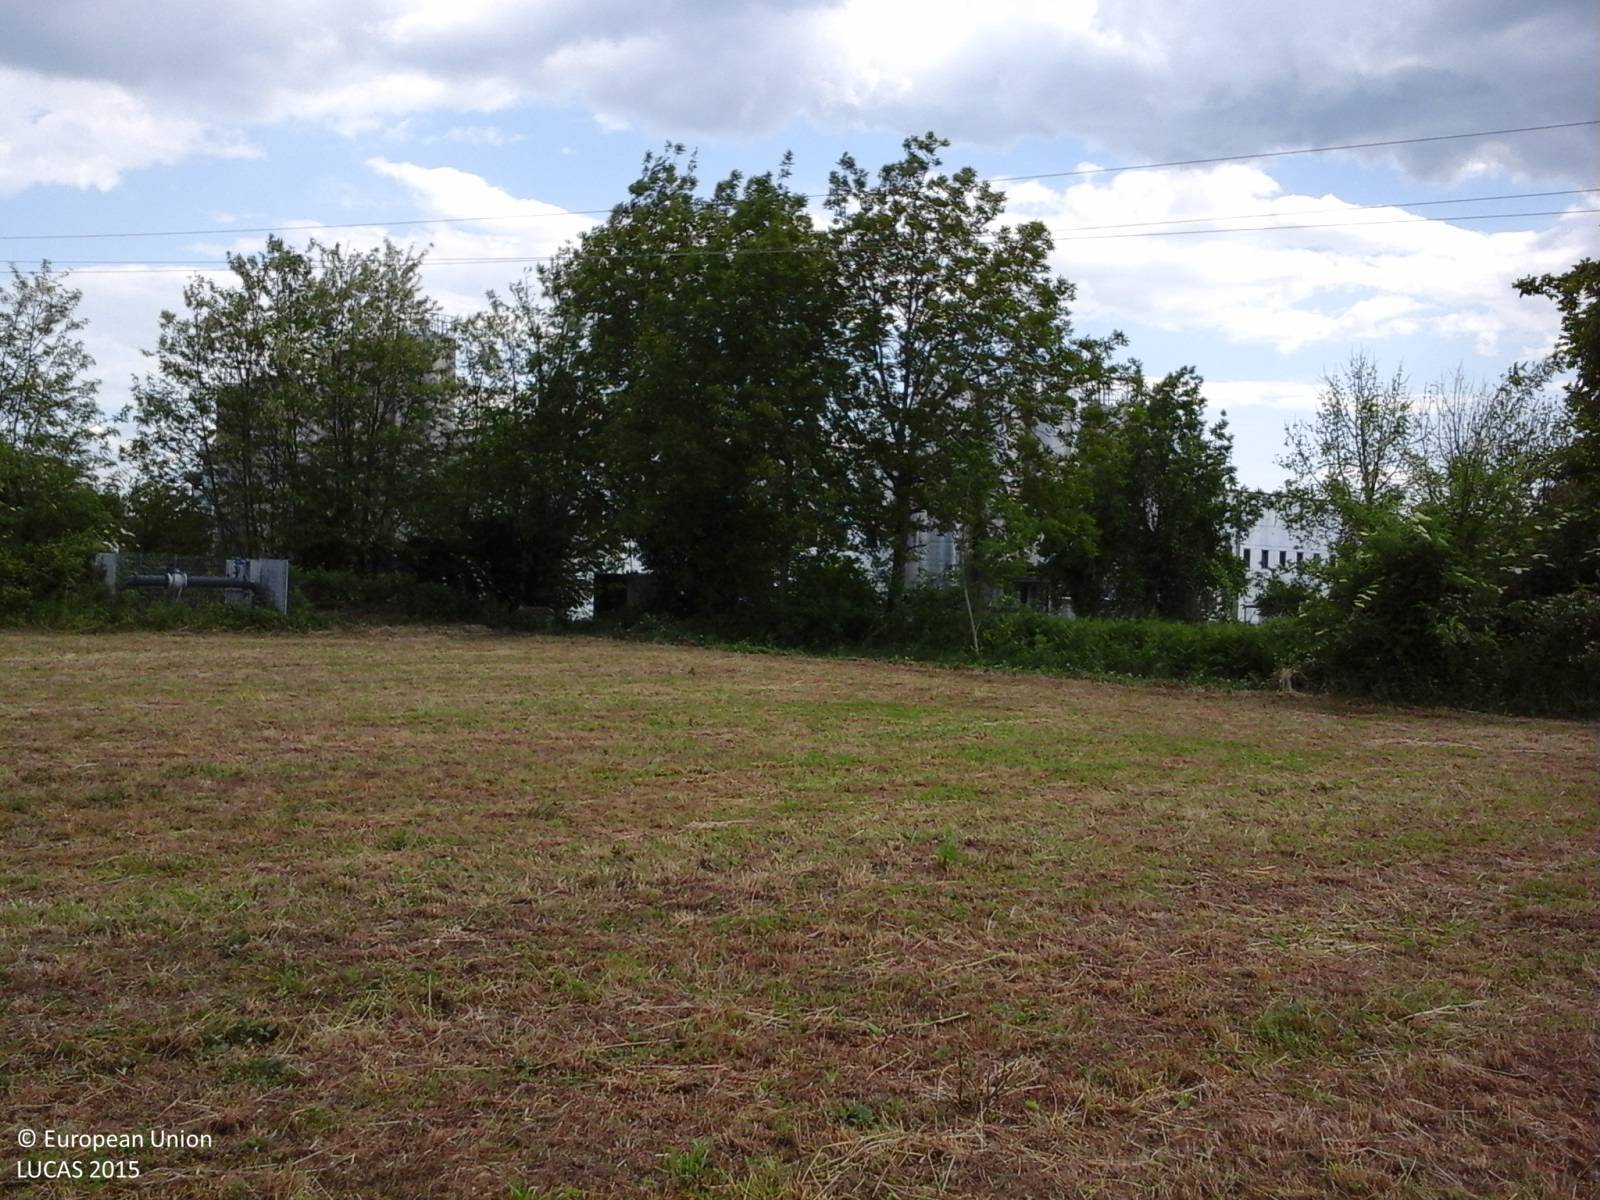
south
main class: Cropland
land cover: Temporary grasslands
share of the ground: 25 - 50 %
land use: Agriculture (excluding fallow land and kitchen gardens)
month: May
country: IT
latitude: 41.2943
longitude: 14.3423
